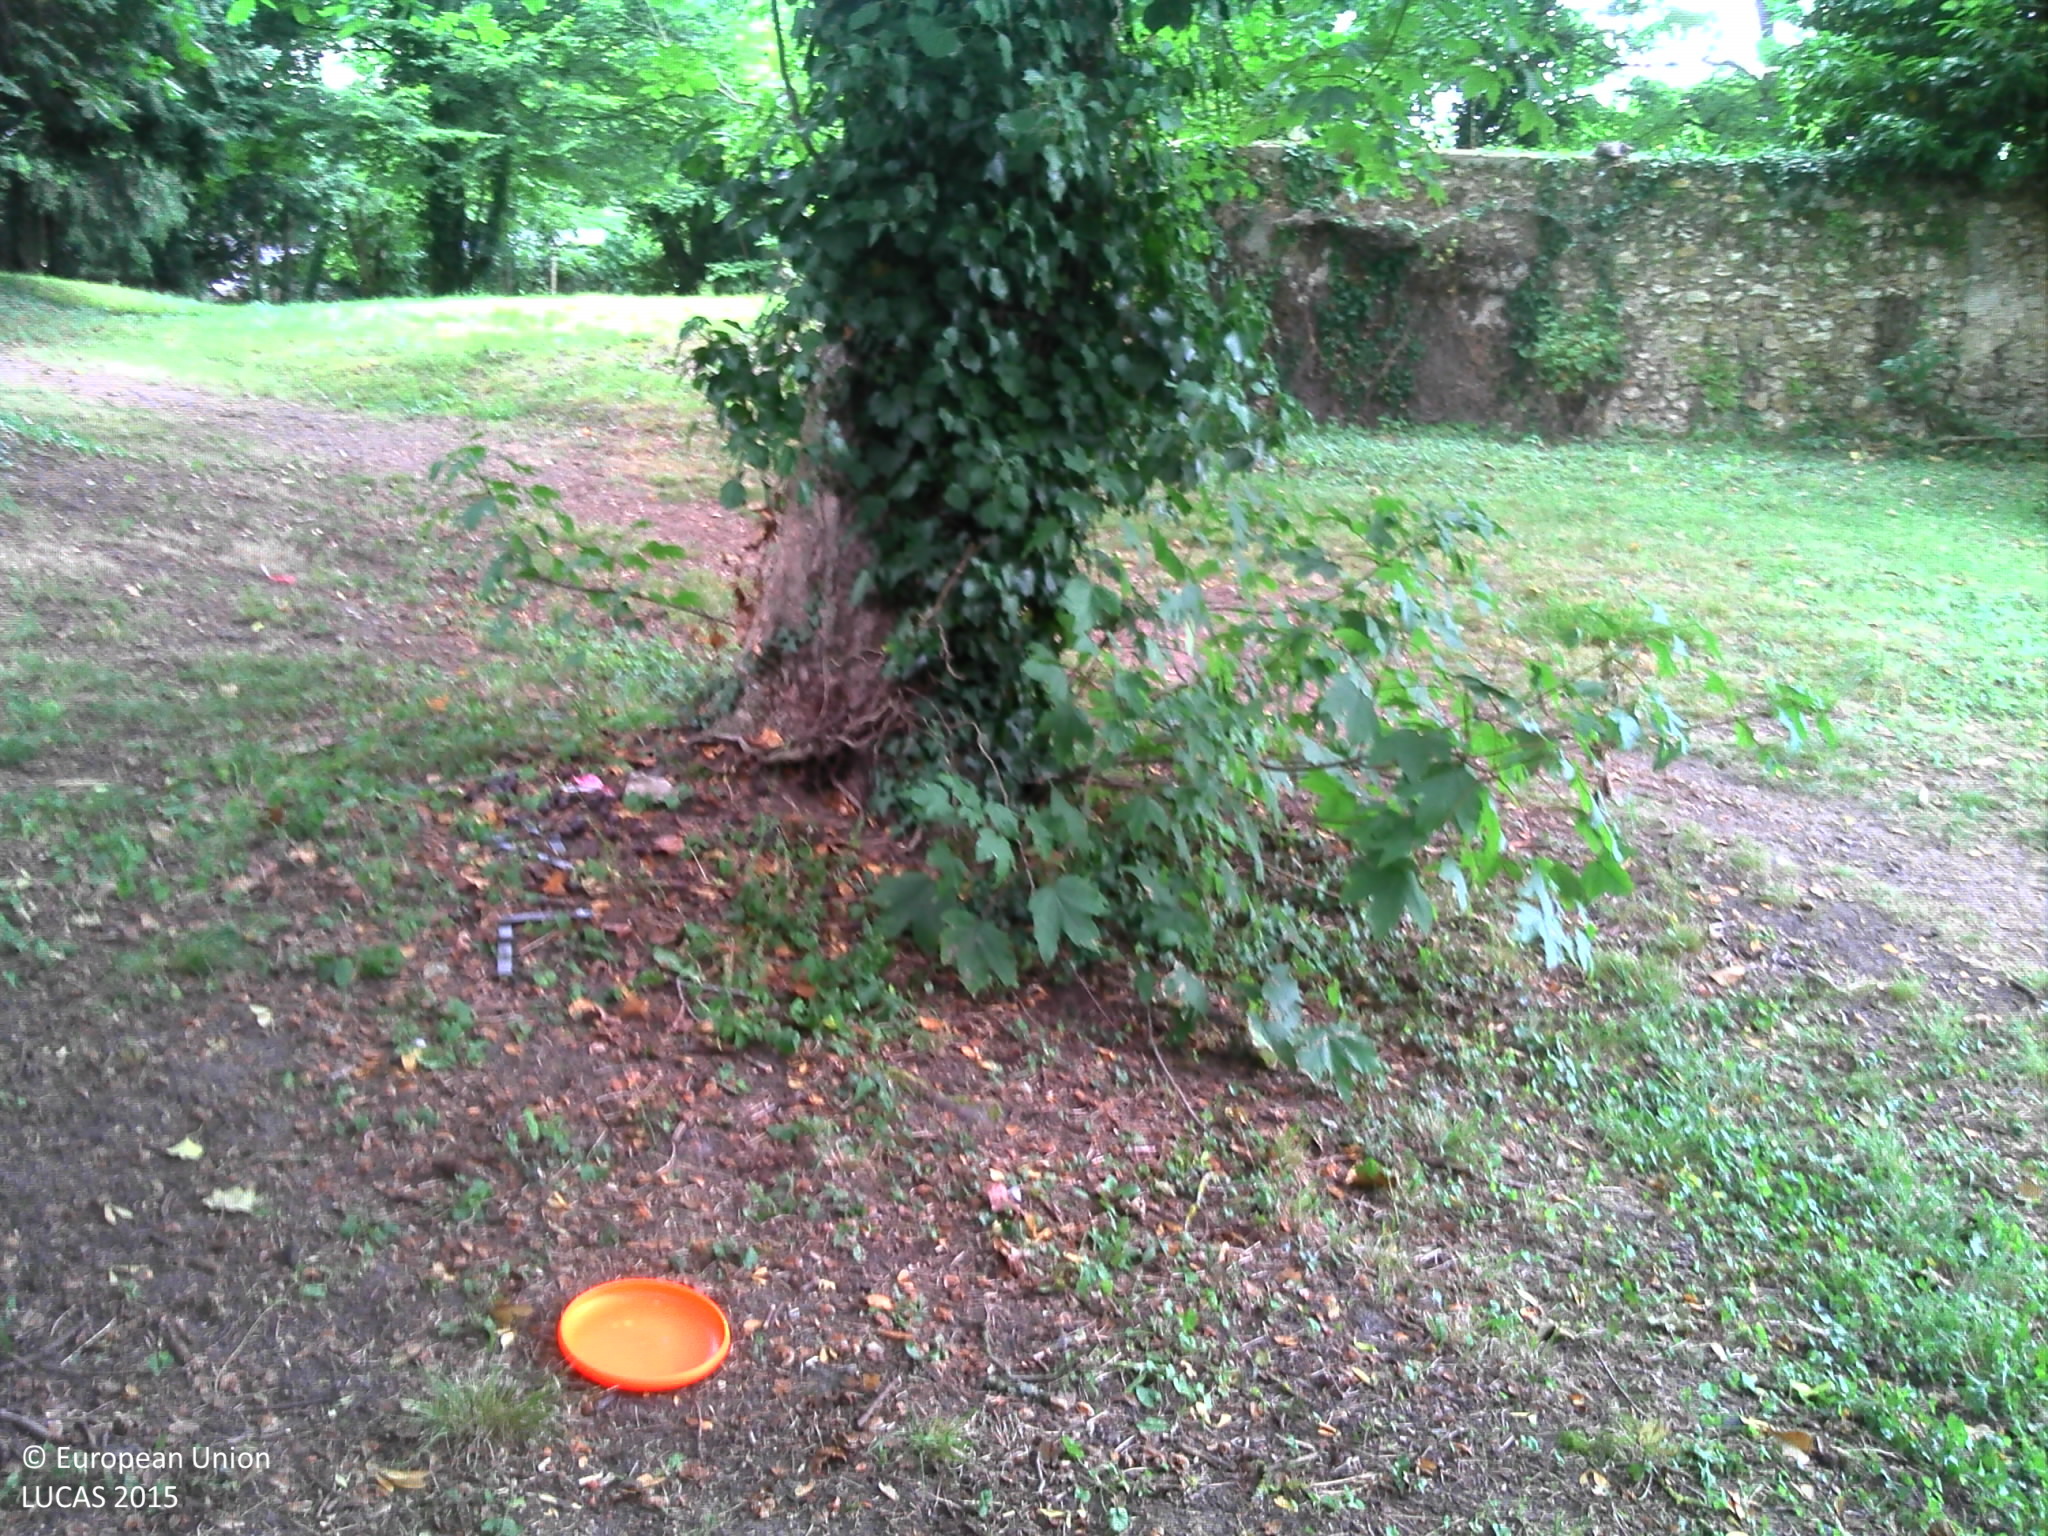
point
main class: Woodland
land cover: Other mixed woodland
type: exotic forest
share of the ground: > 75 %
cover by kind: coniferous forest trees 55 %, broadleaved forest trees 20 %, herbaceous plants 20 %, lichens and mosses 5 %
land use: Amenities, museums, leisure
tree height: > 5 m
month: July
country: FR
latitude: 47.2873
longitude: 0.7125
